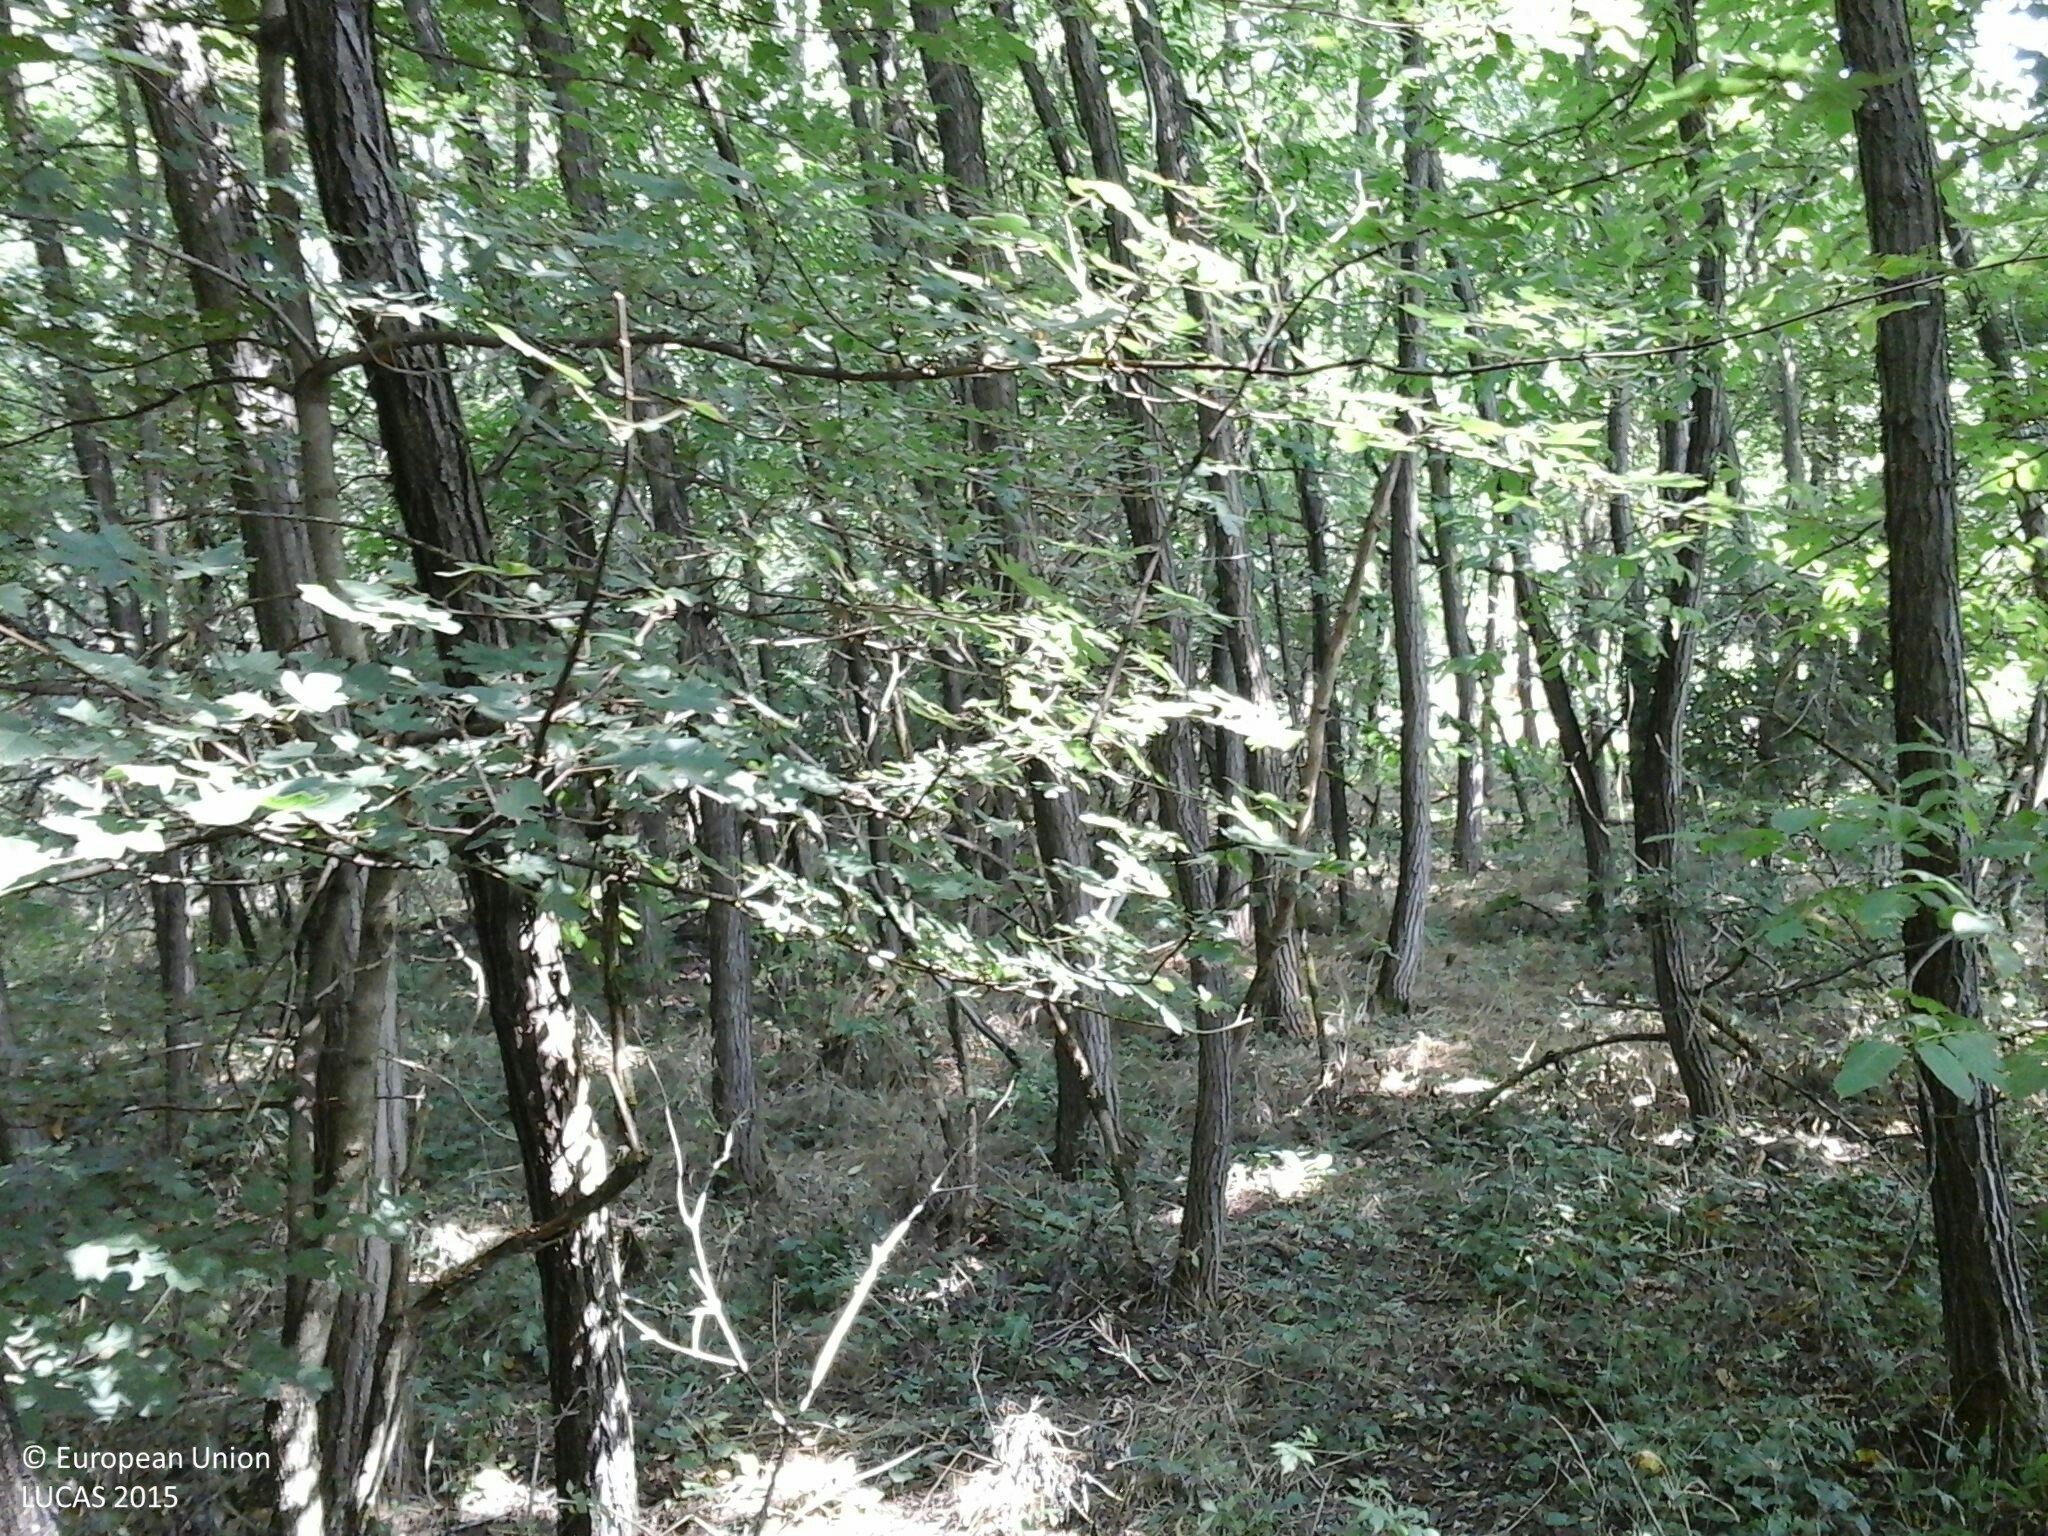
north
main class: Woodland
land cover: Broadleaved woodland
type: mesophytic deciduous forest
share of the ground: > 75 %
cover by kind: broadleaved forest trees 85 %, shrubs 10 %, herbaceous plants 5 %
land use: Forestry
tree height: > 5 m
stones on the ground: < 10 %
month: August
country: HU
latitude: 46.7128
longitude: 18.1061
